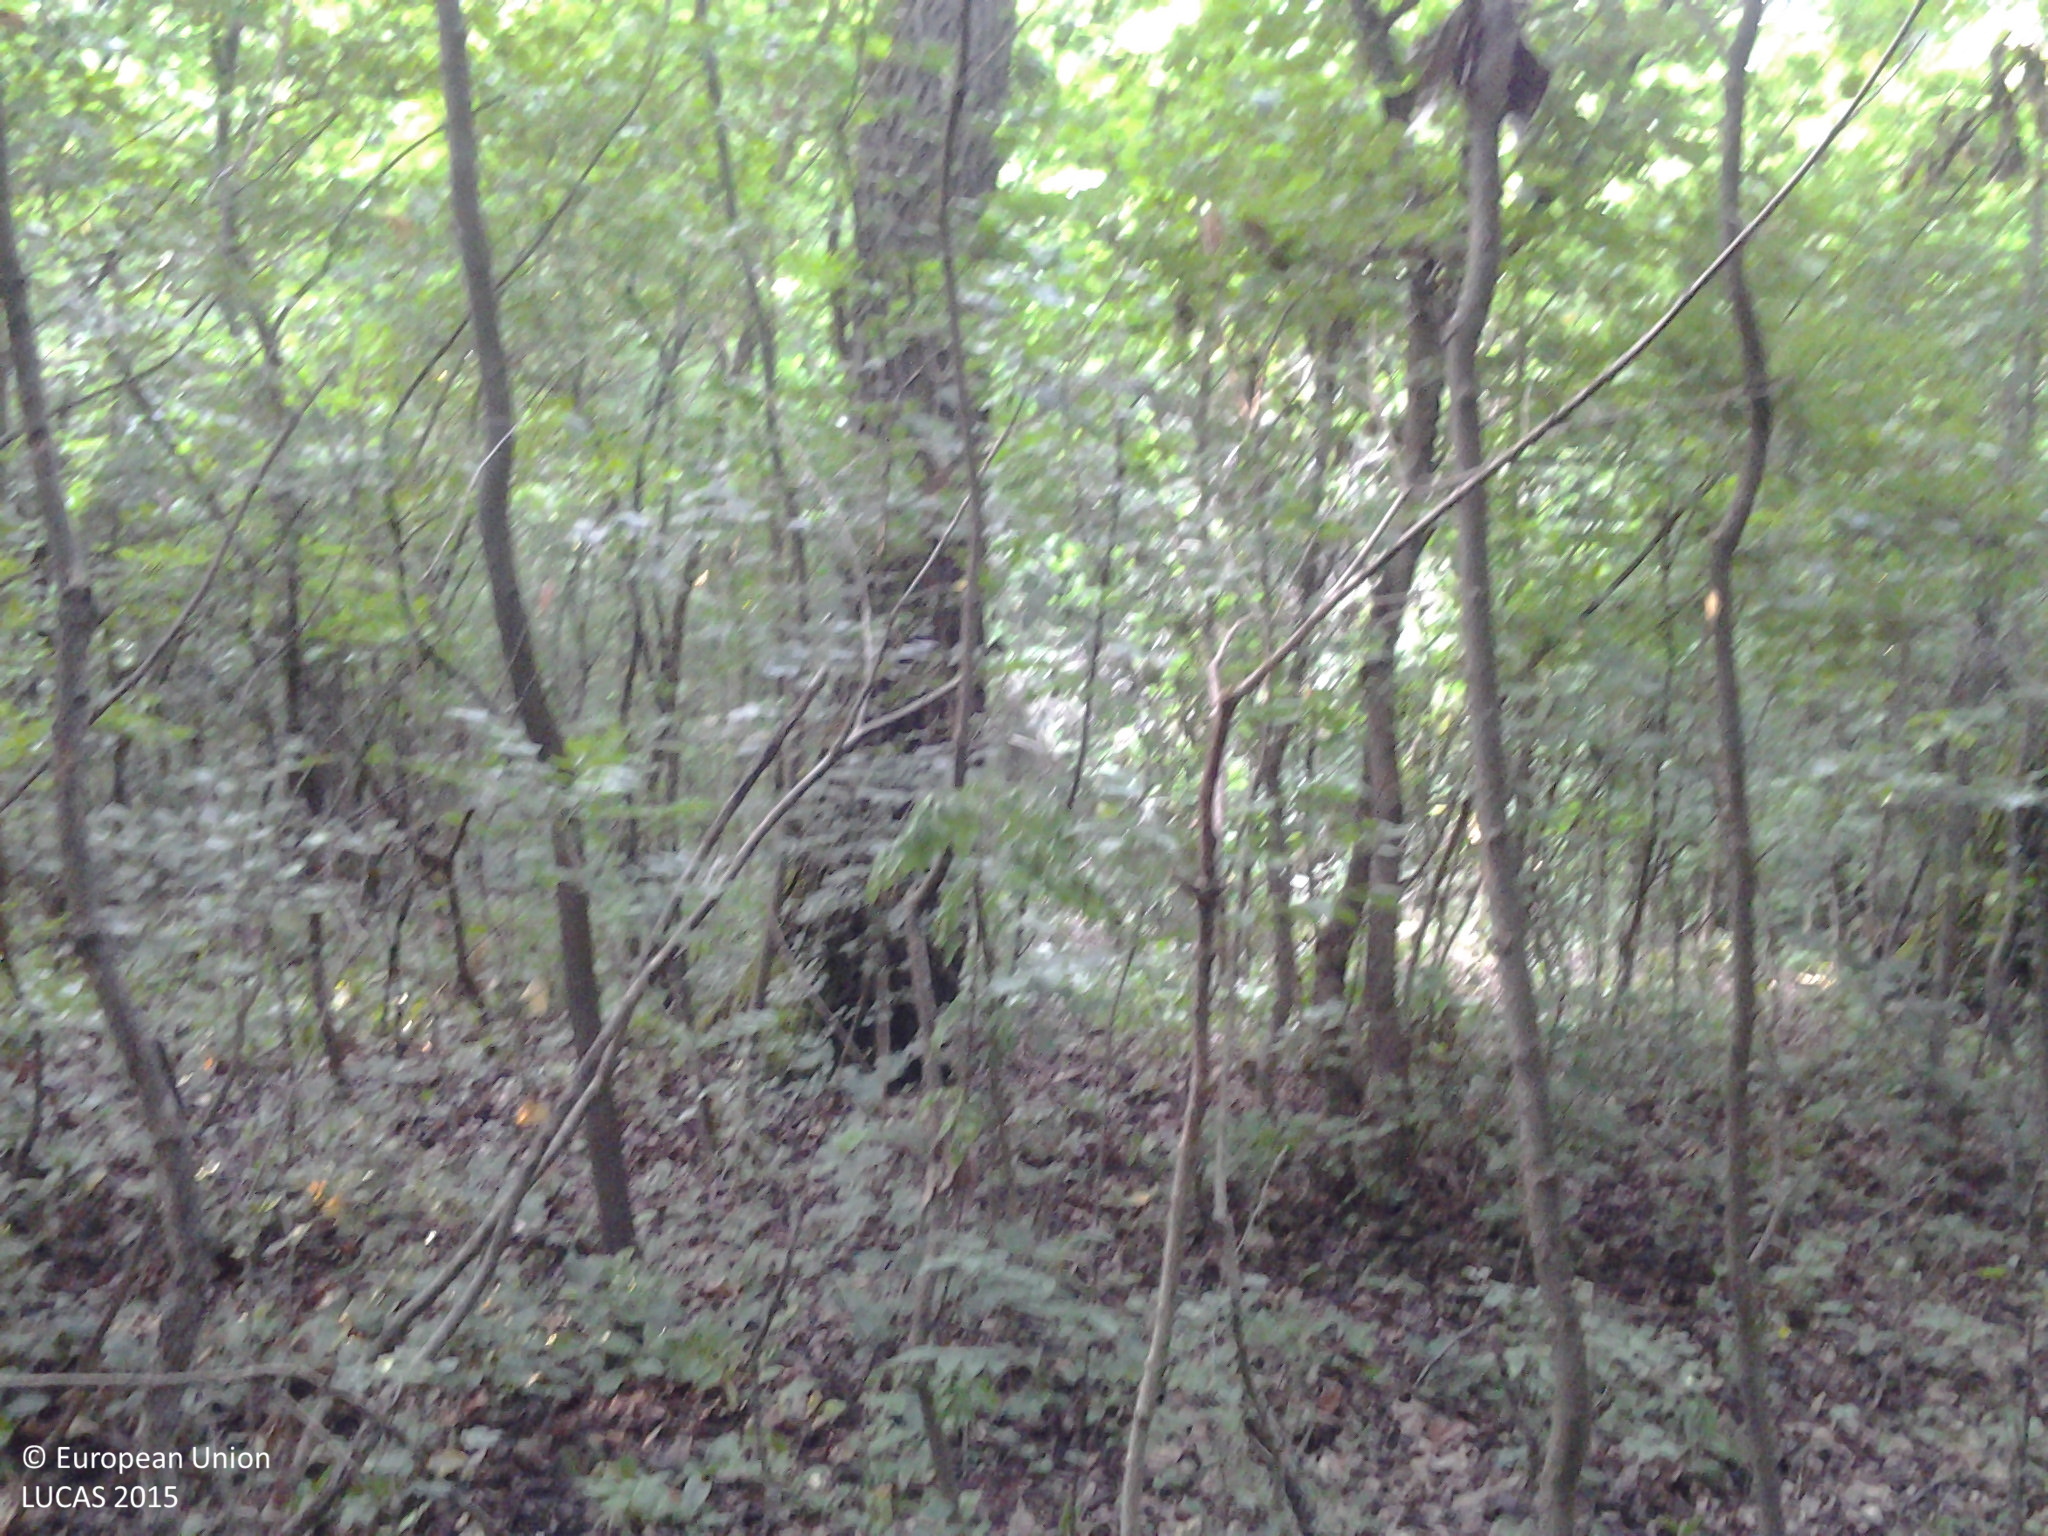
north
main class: Woodland
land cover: Broadleaved woodland
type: mesophytic deciduous forest
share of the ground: > 75 %
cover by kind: broadleaved forest trees 100 %
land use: Forestry
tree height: > 5 m
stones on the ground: 10 - 25 %
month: June
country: RO
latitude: 44.1595
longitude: 26.1465
